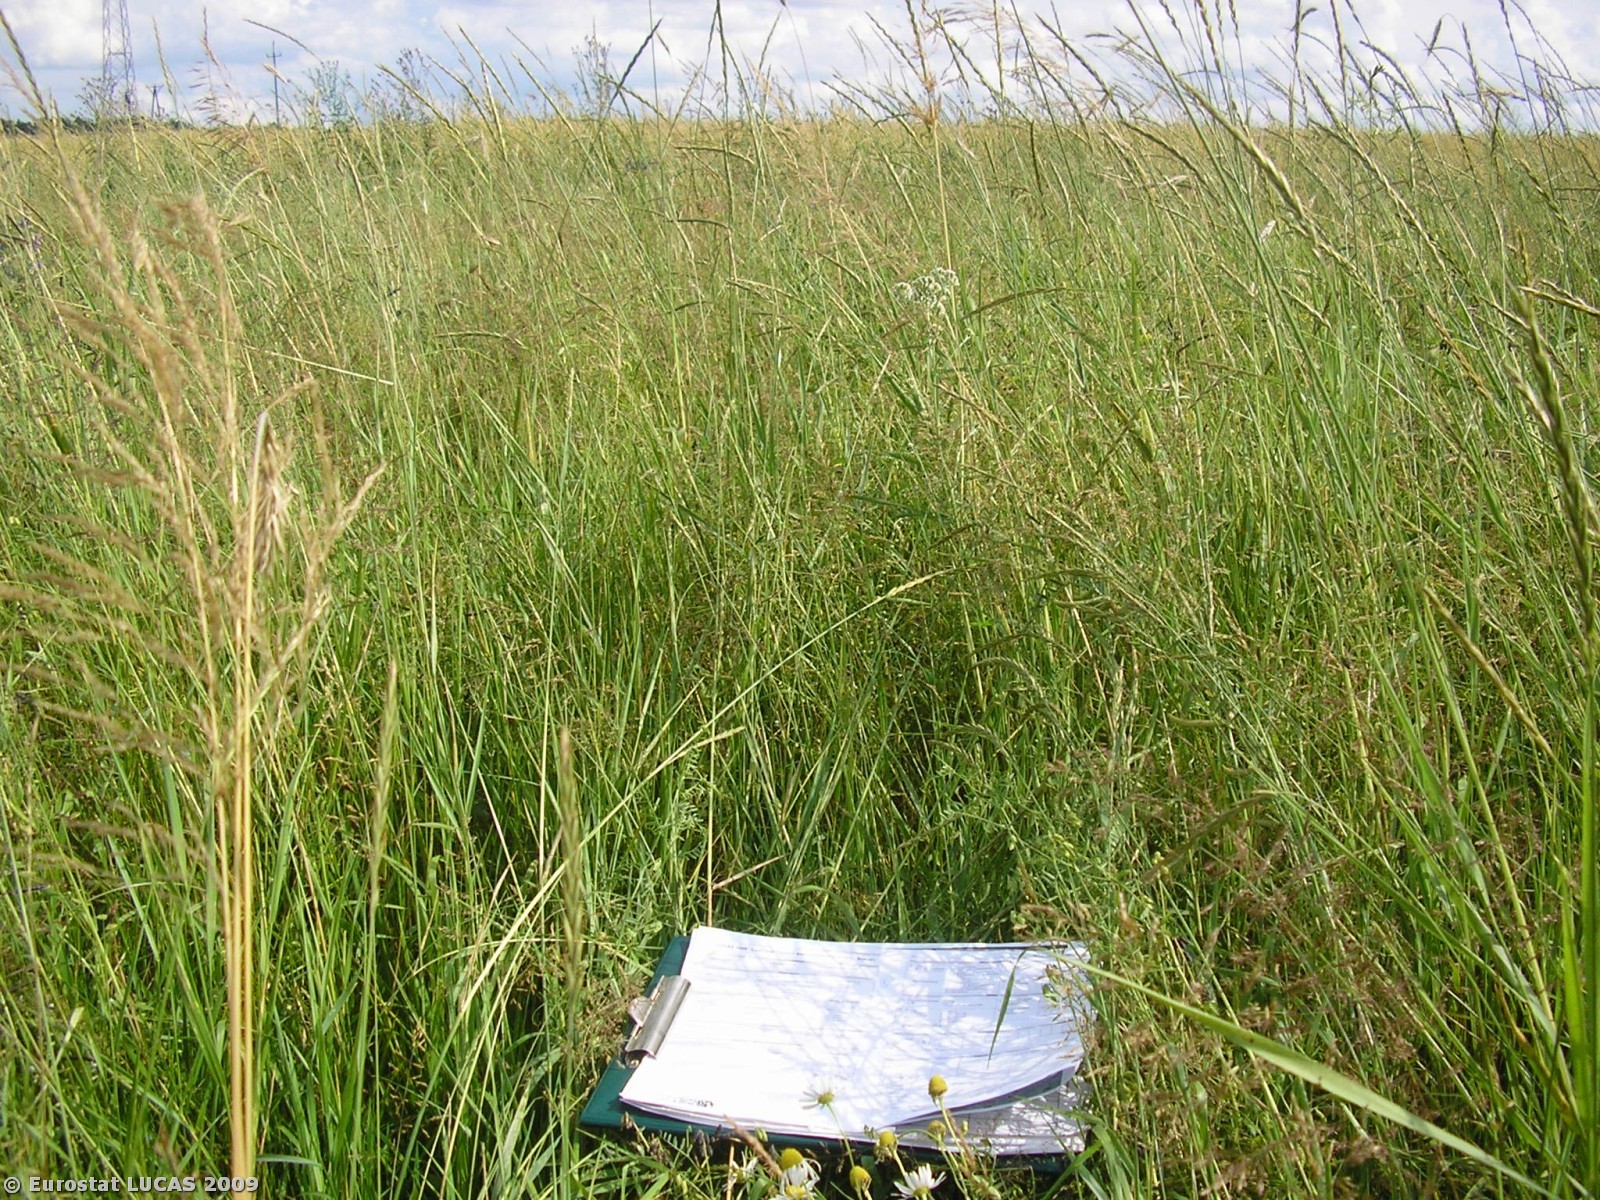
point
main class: Grassland
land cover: Grassland without tree/shrub cover
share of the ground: > 75 %
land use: Agriculture (excluding fallow land and kitchen gardens)
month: July
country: PL
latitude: 51.4567
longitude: 21.4634
